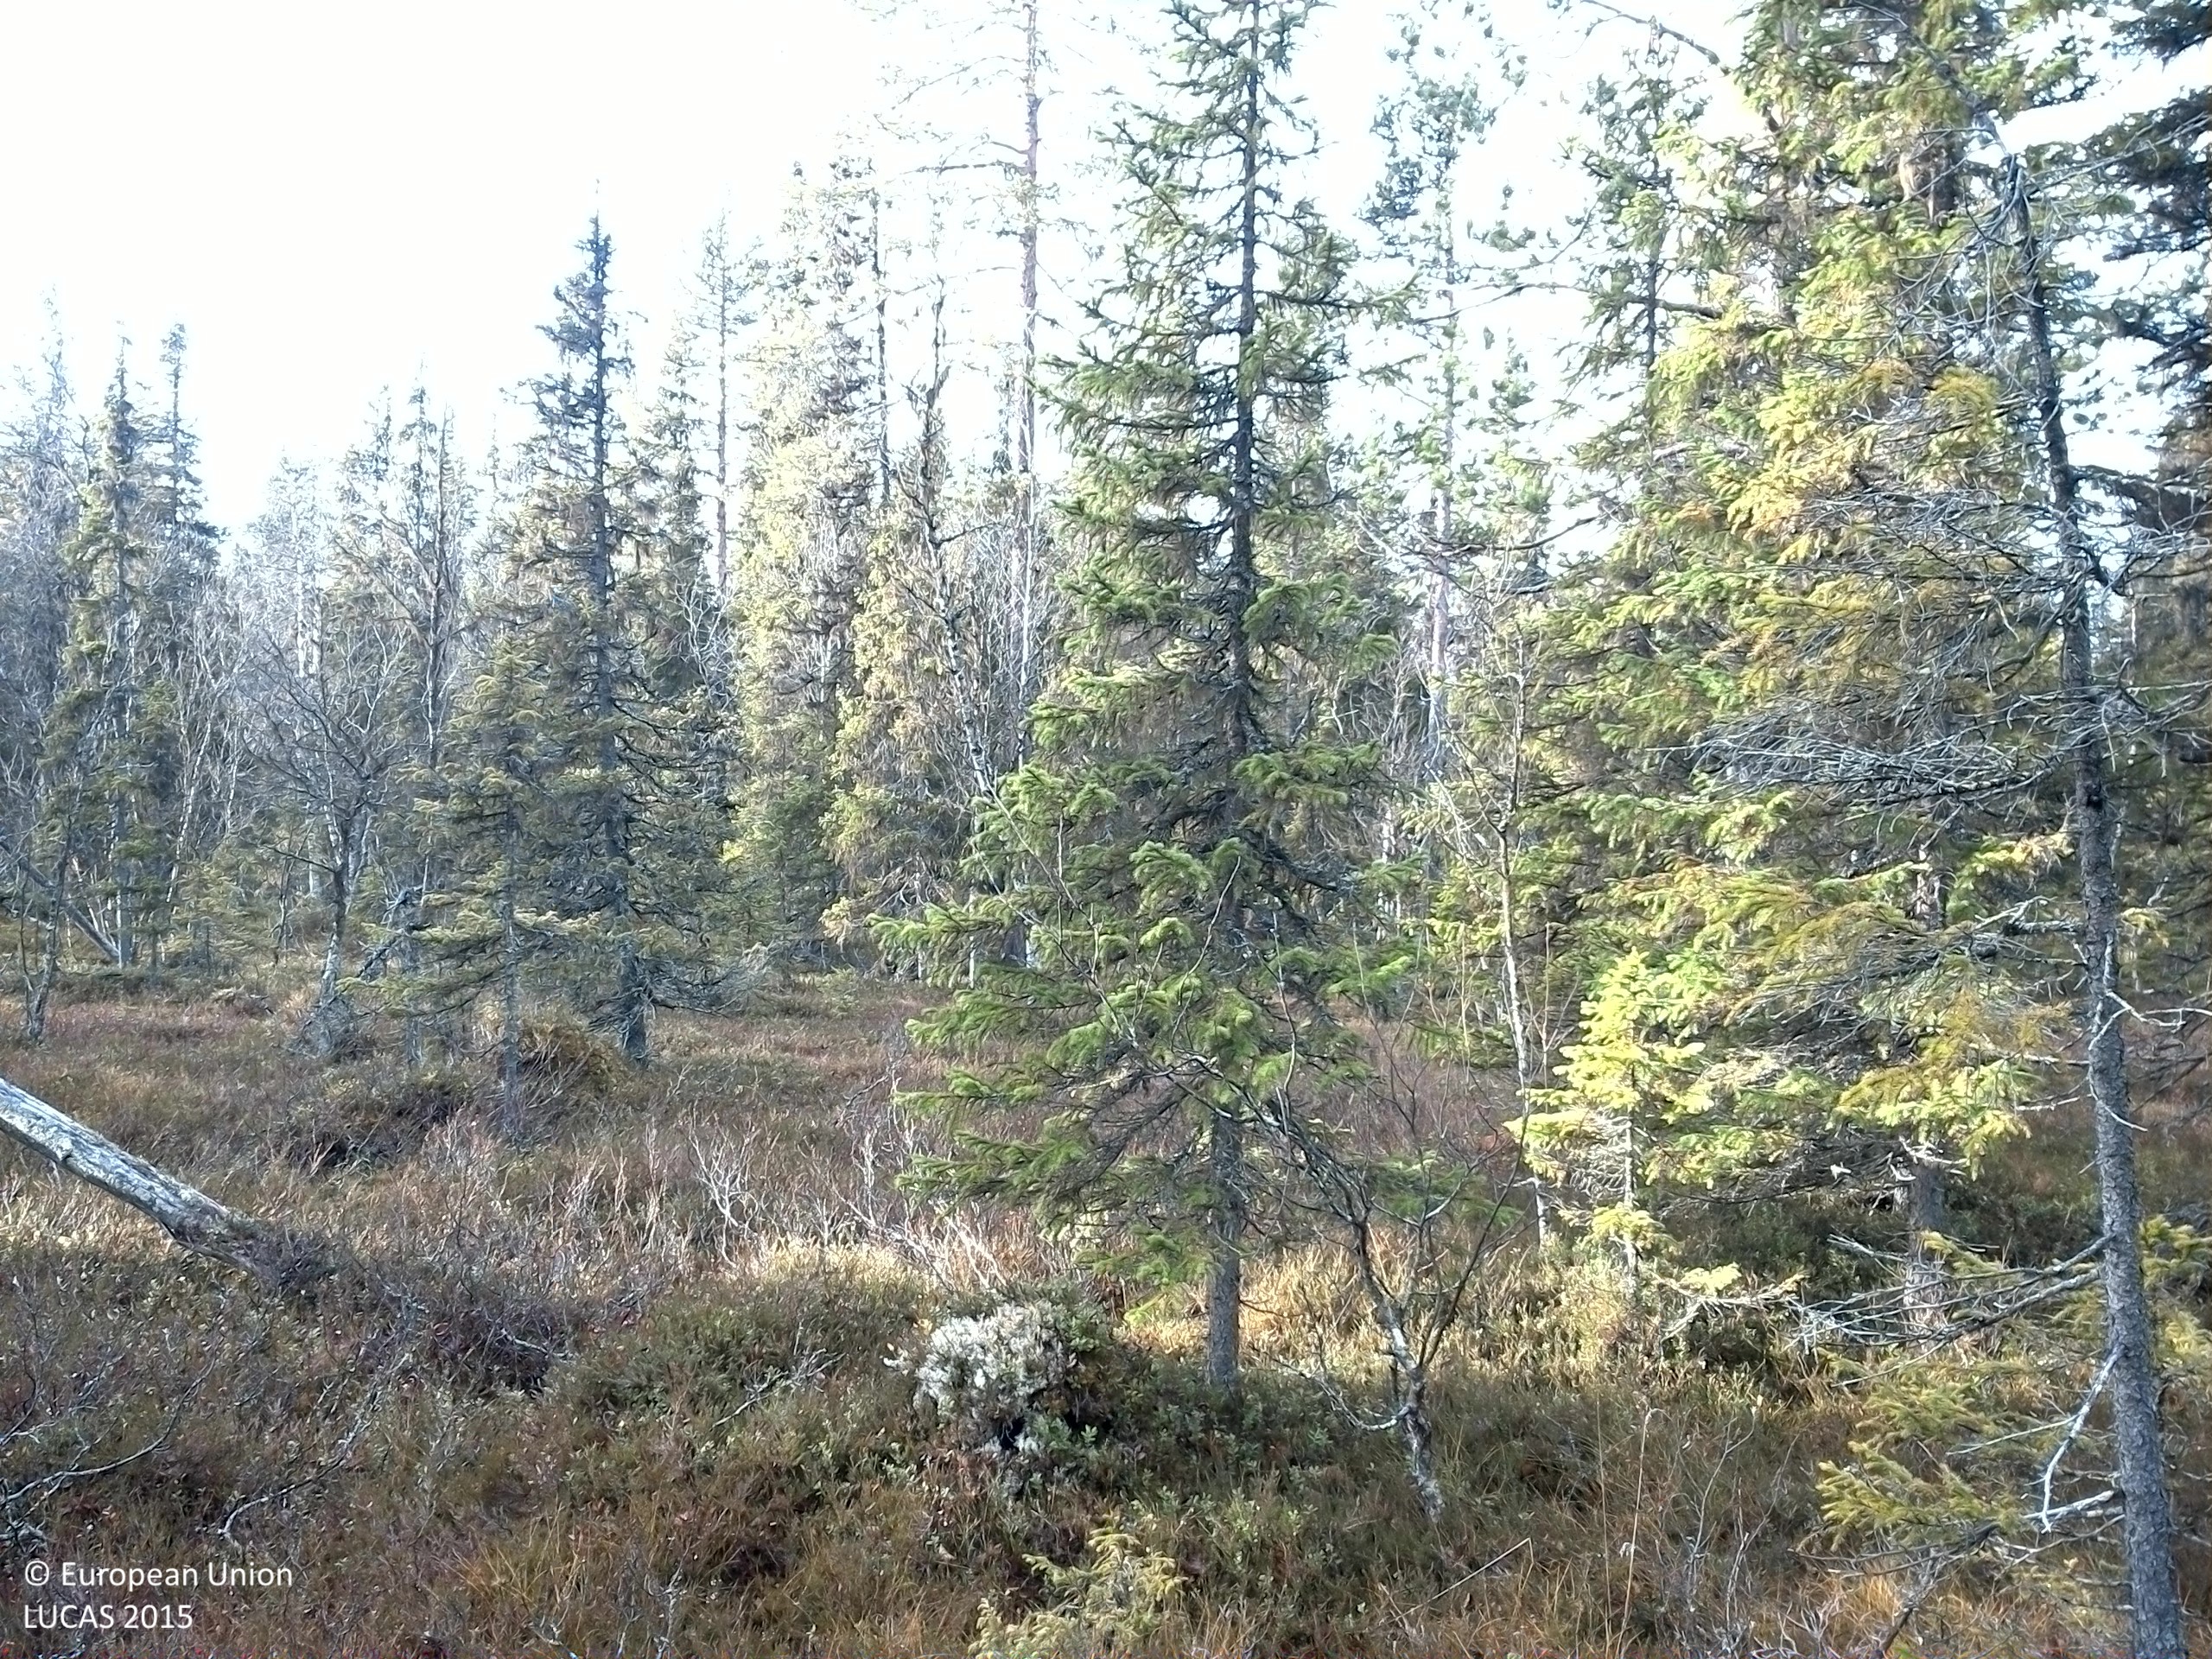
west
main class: Woodland
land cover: Spruce dominated coniferous woodland
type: boreal forest
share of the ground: 25 - 50 %
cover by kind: coniferous forest trees 40 %, shrubs 40 %, lichens and mosses 15 %, broadleaved forest trees 5 %
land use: Forestry
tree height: > 5 m
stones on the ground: < 10 %
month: October
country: SE
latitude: 64.2152
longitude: 14.8568
